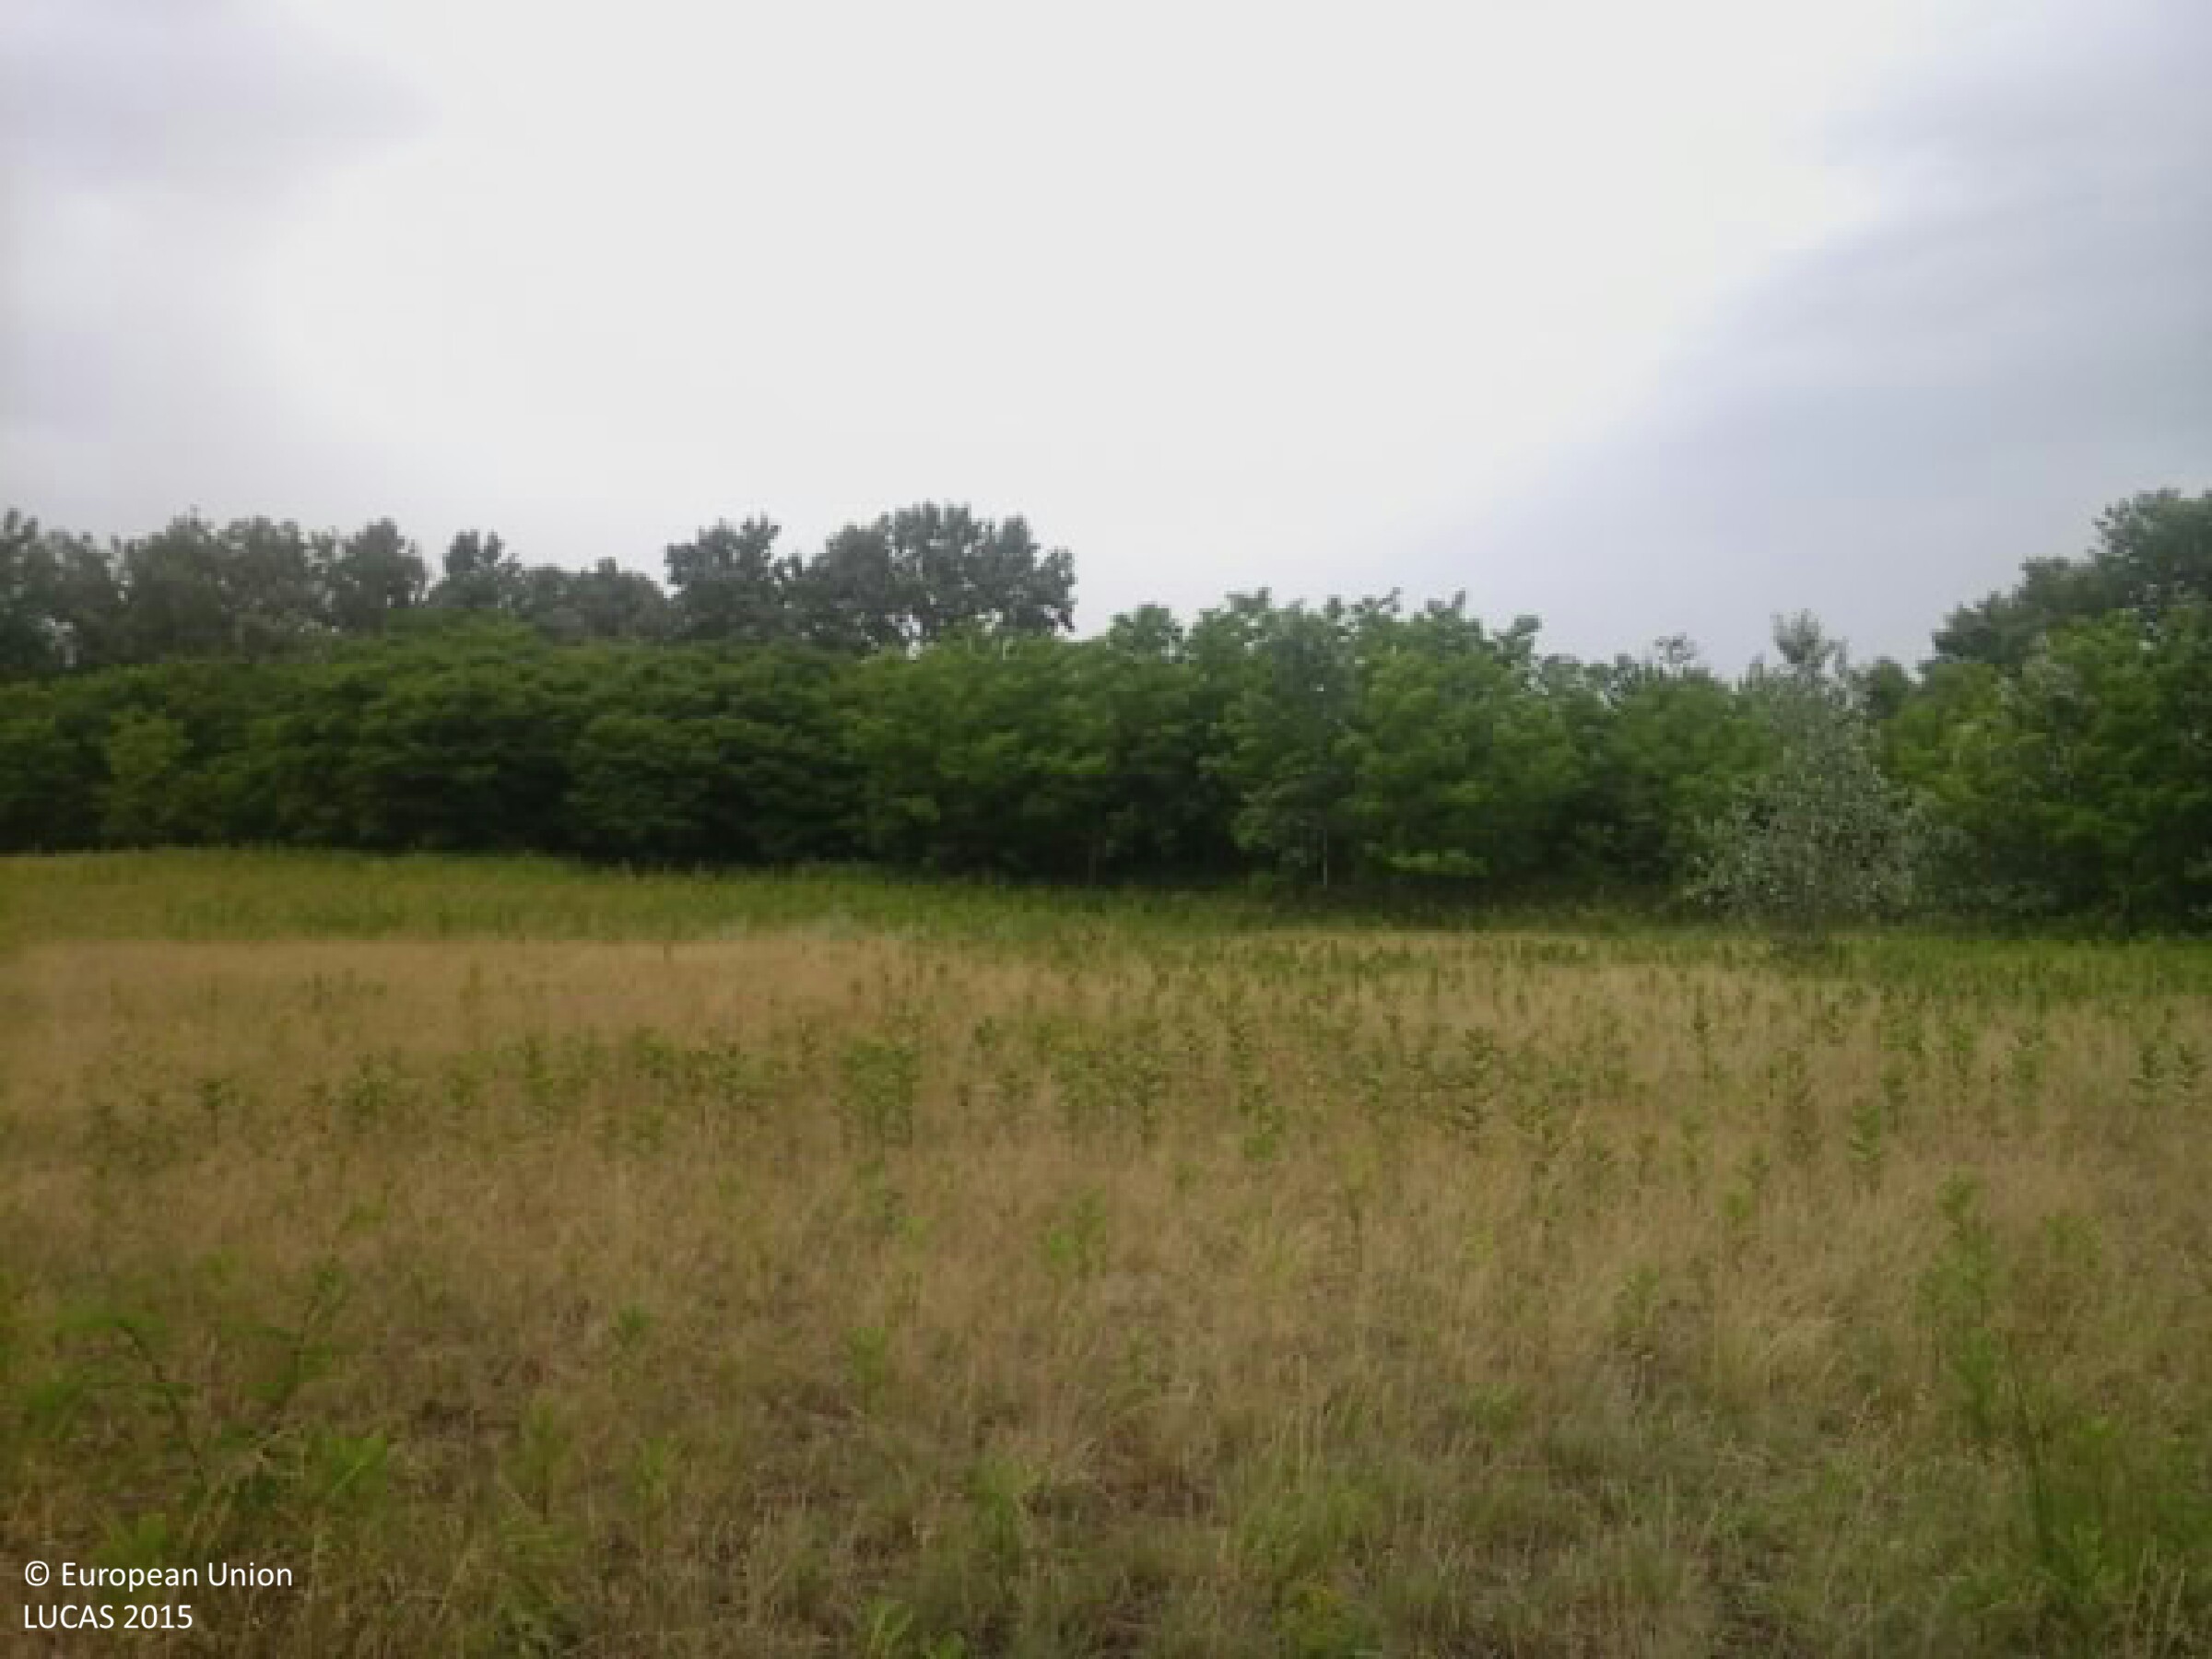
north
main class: Grassland
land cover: Grassland without tree/shrub cover
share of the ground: > 75 %
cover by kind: herbaceous plants 100 %
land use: Abandoned areas
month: June
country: HU
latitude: 46.7667
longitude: 19.6441
